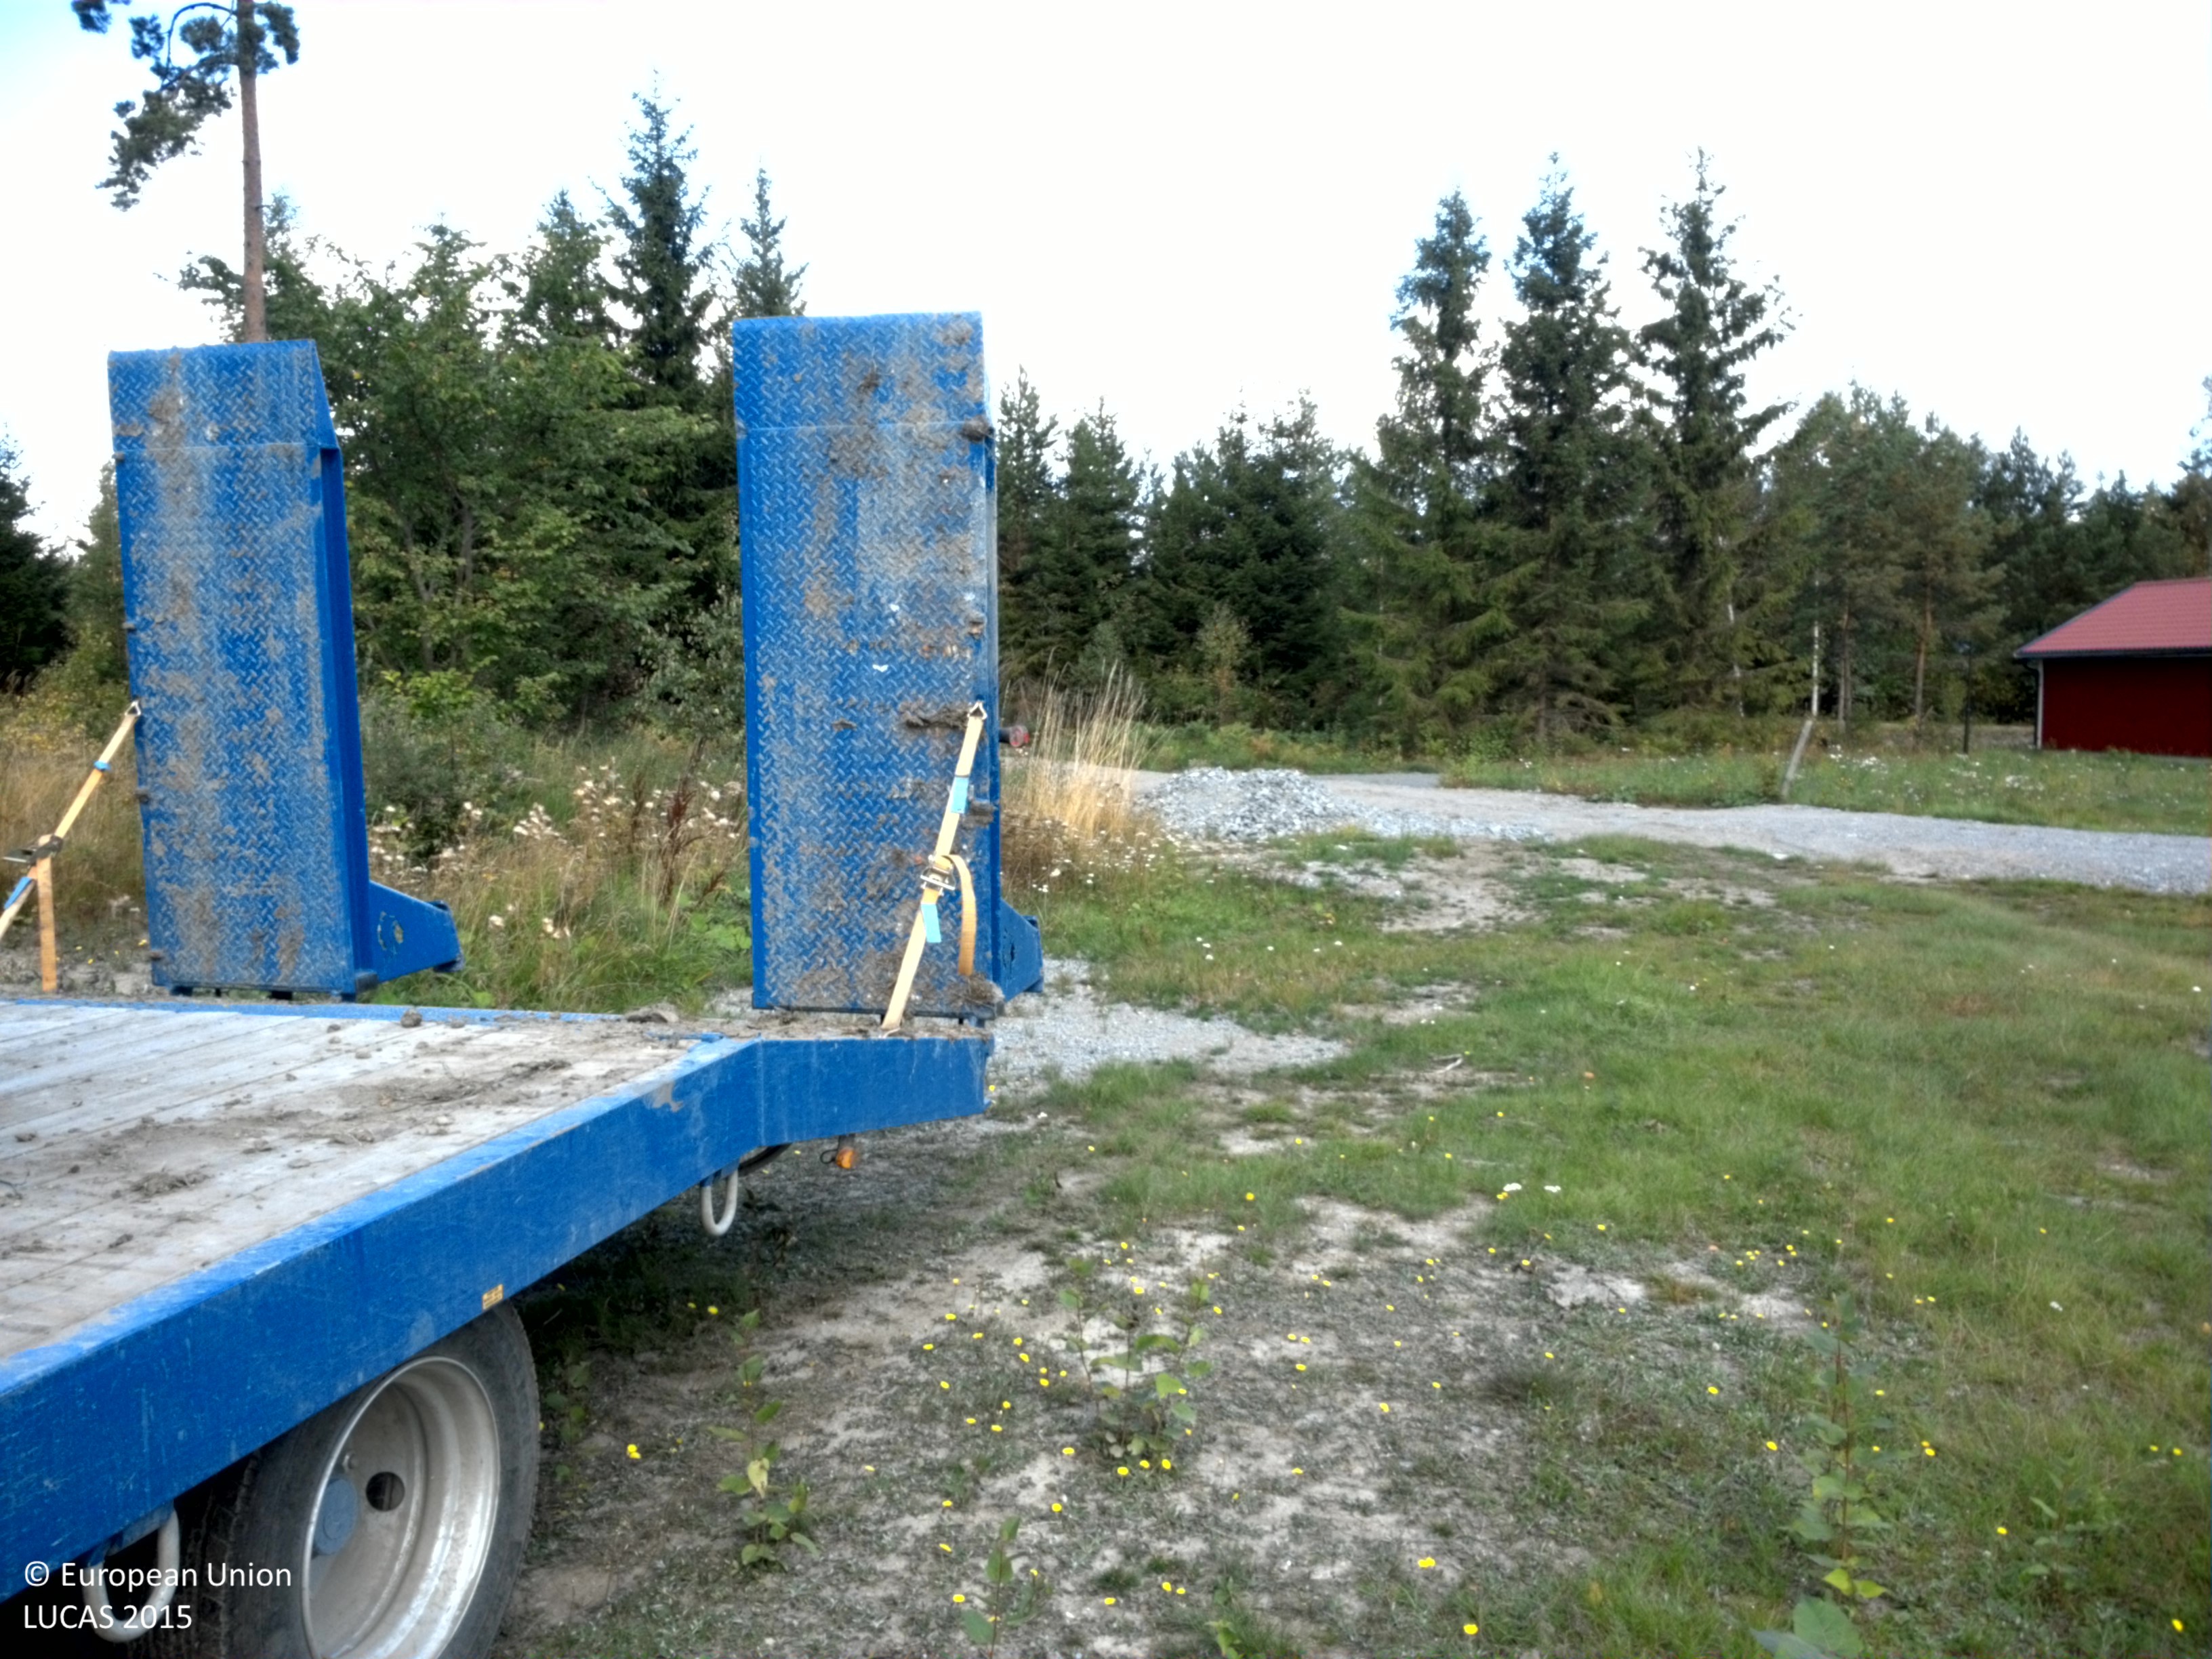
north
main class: Grassland
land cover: Grassland without tree/shrub cover
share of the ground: > 75 %
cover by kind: herbaceous plants 100 %
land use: Residential
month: August
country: SE
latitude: 59.6895
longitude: 17.8655
